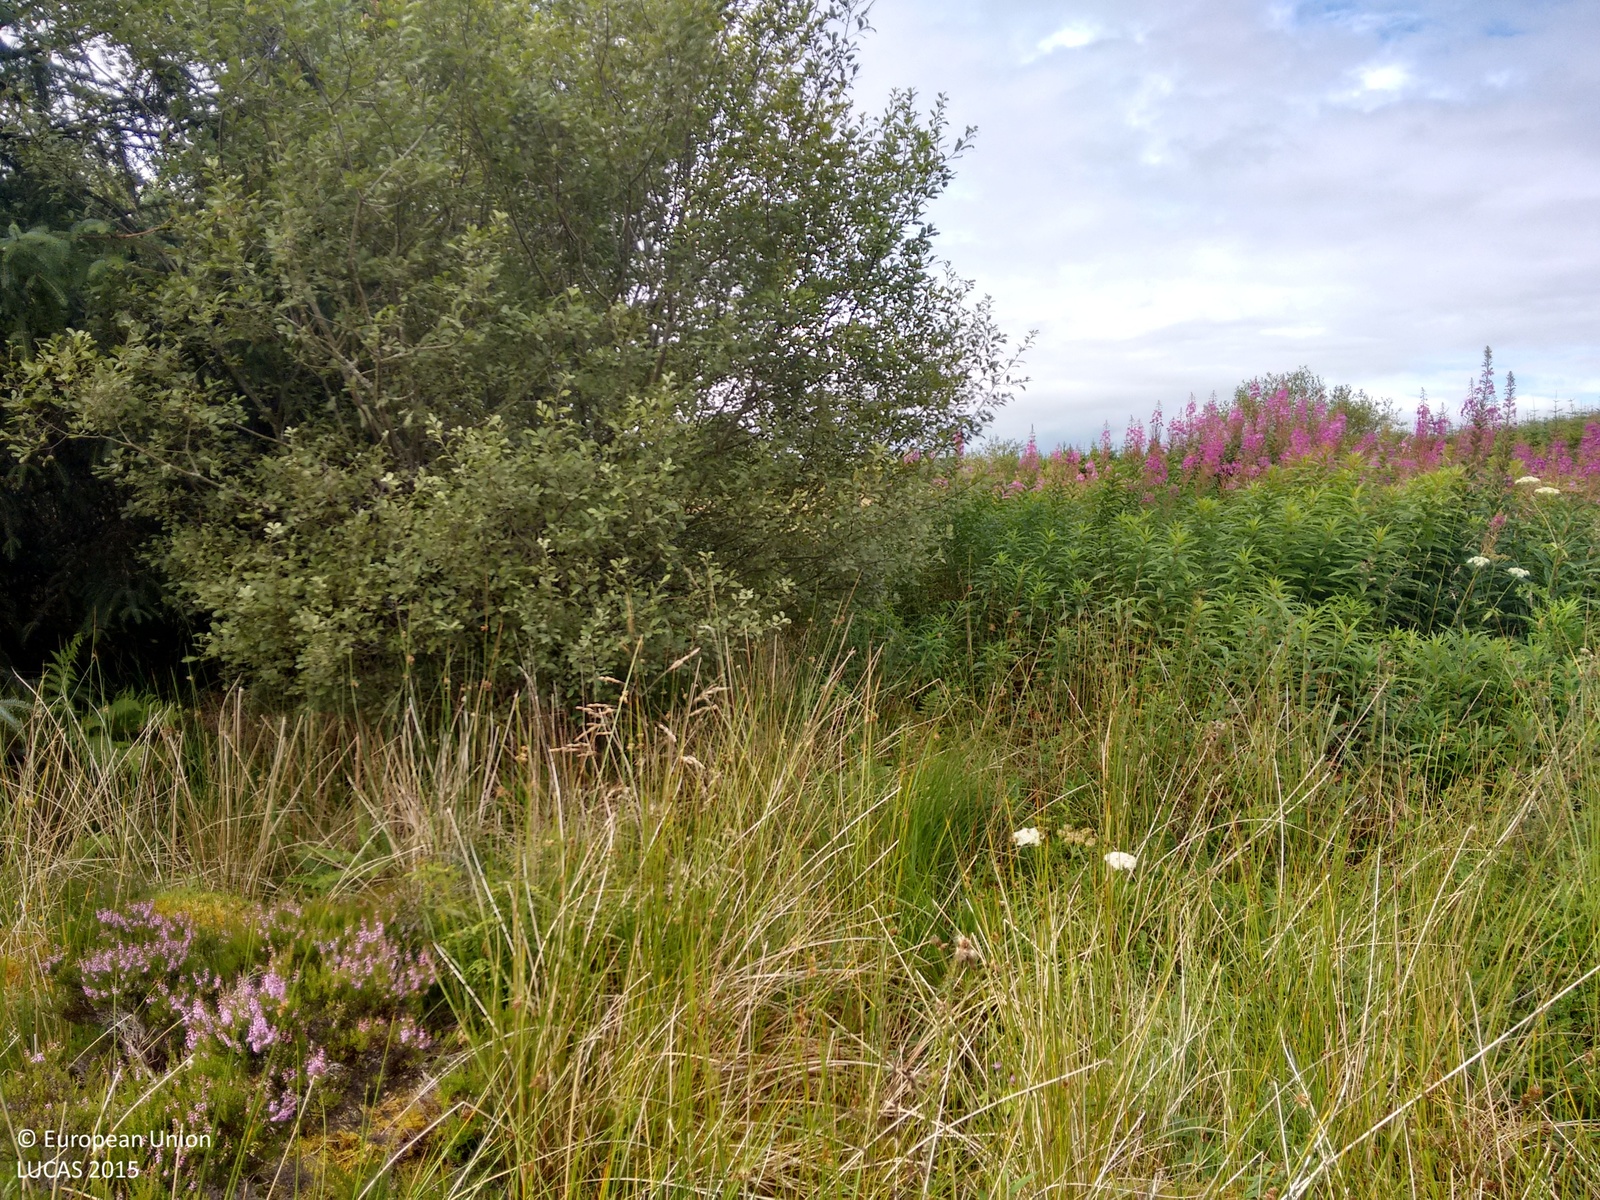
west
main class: Woodland
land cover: Spruce dominated coniferous woodland
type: exotic forest
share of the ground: > 75 %
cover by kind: coniferous forest trees 100 %
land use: Forestry
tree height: > 5 m
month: September
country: GB
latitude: 55.2416
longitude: -4.5560
